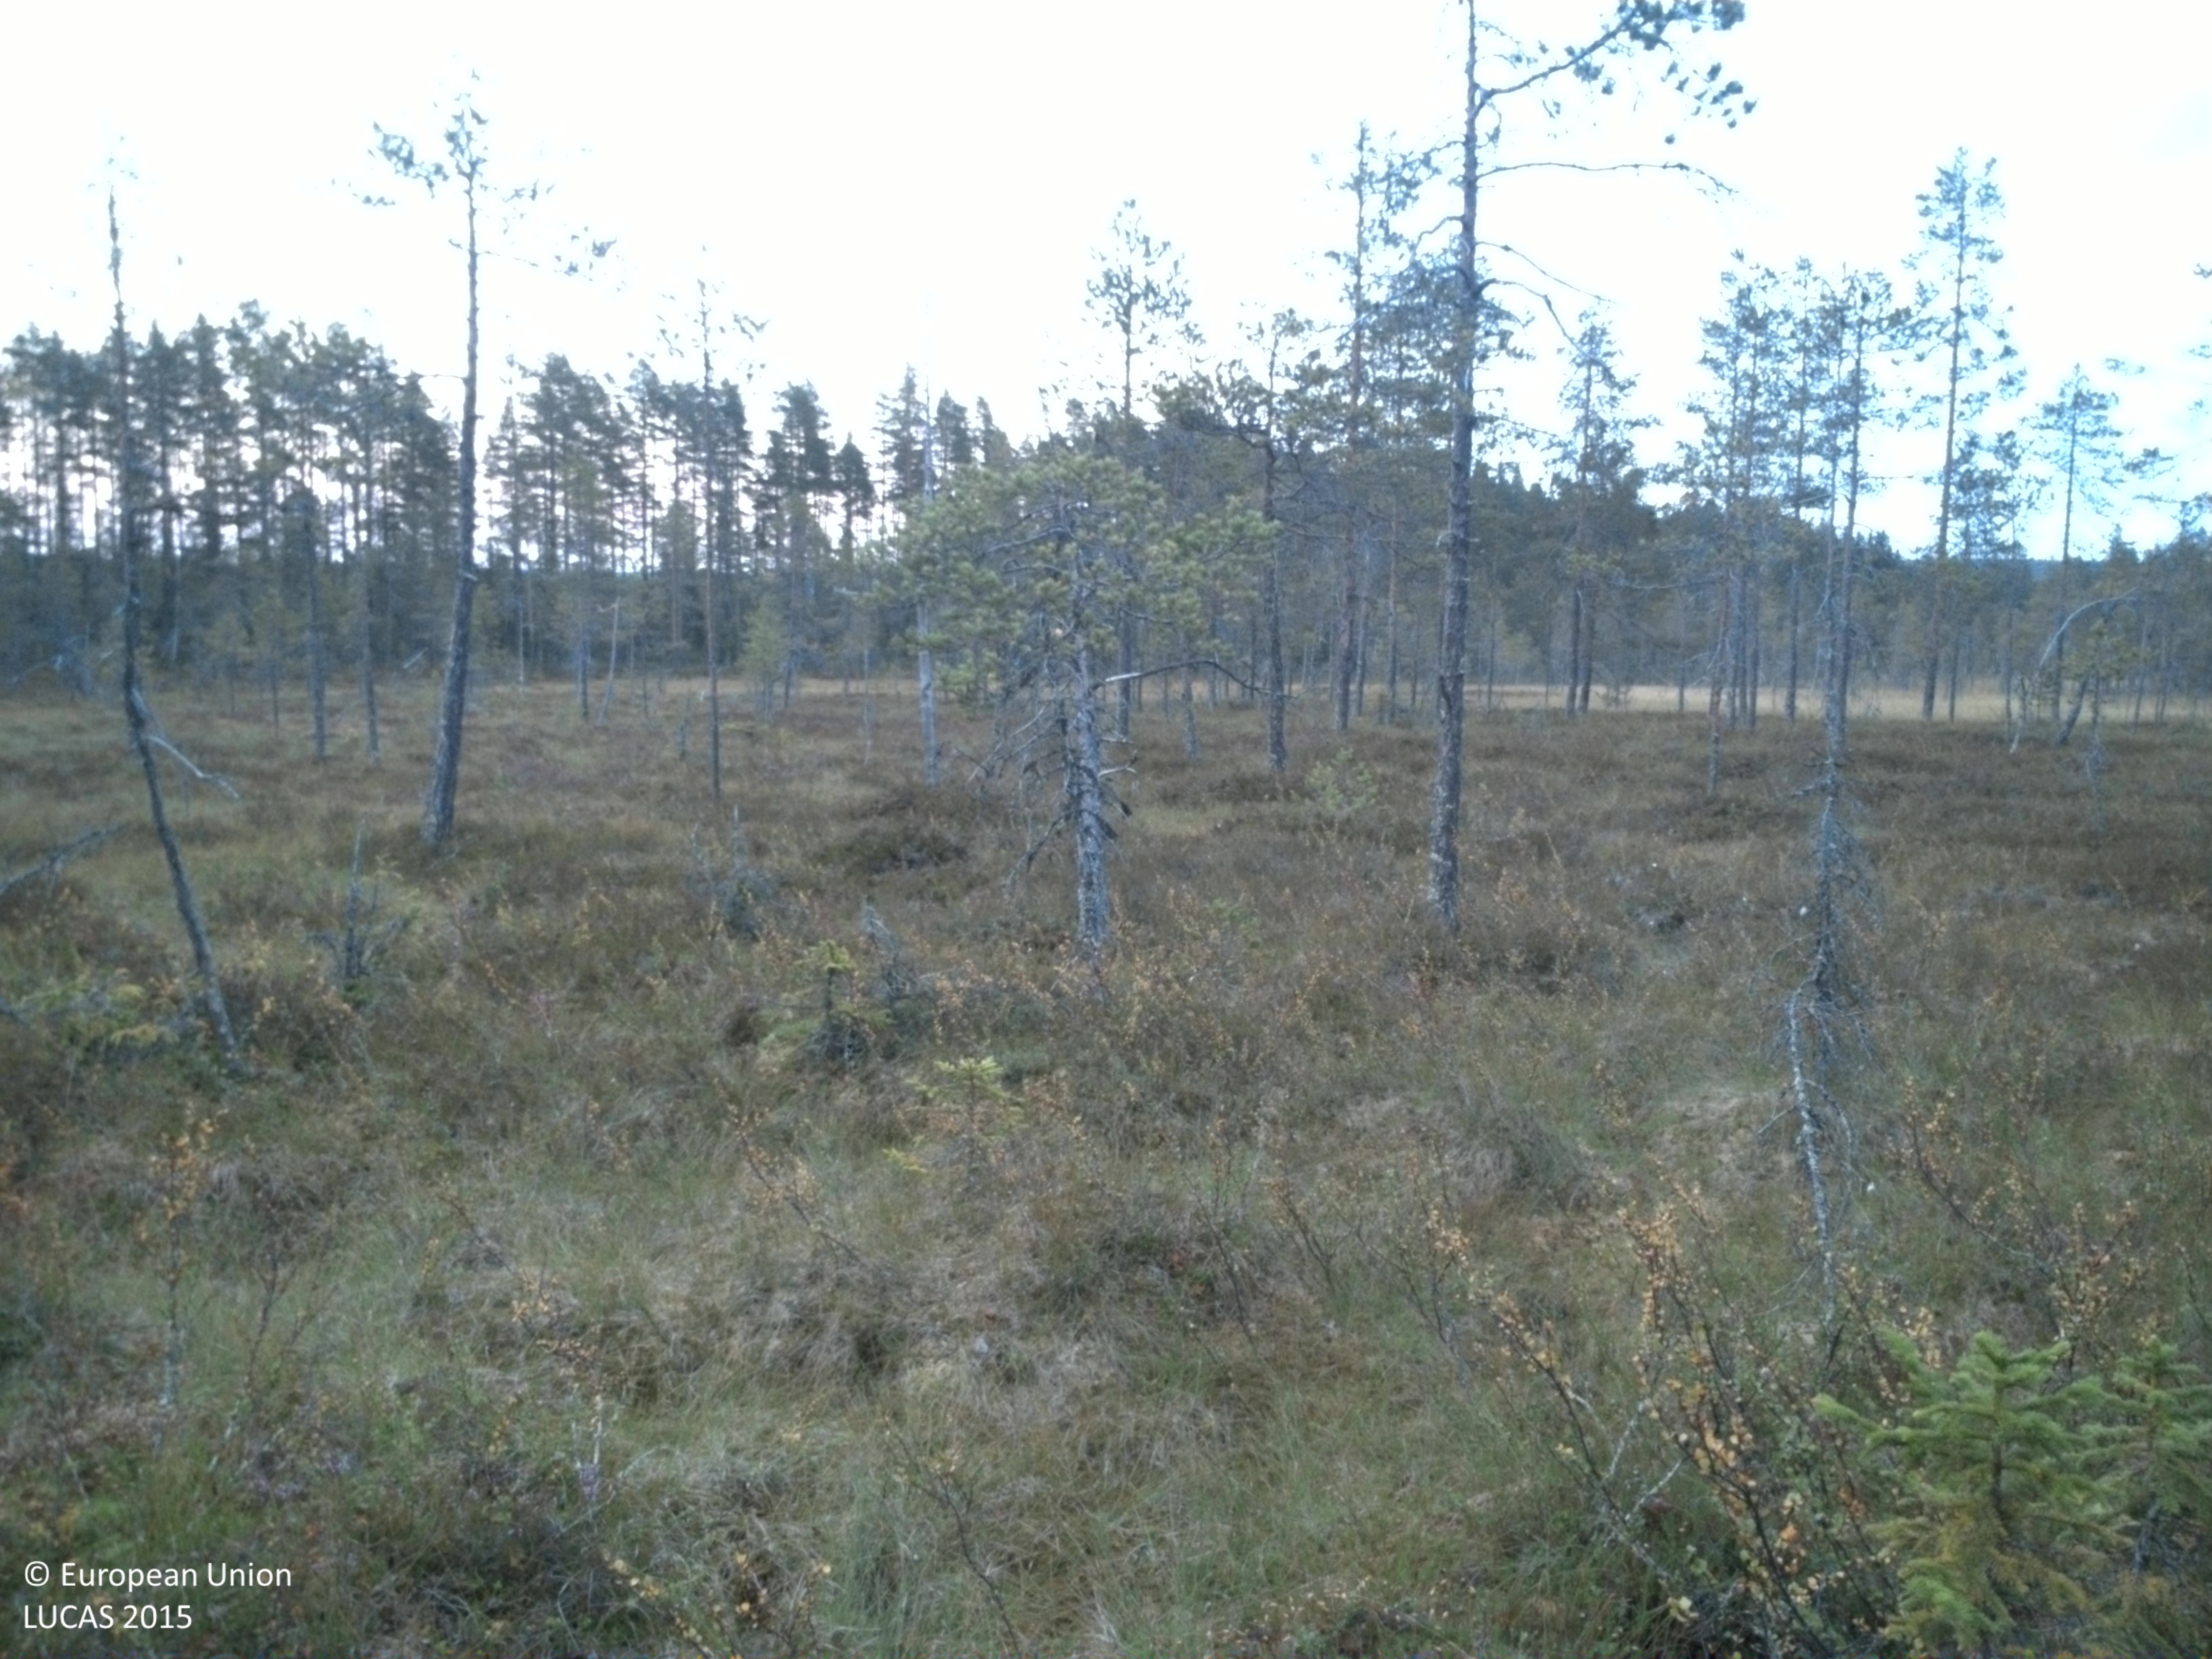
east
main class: Woodland
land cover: Other mixed woodland
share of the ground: 25 - 50 %
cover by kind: shrubs 25 %, lichens and mosses 25 %, coniferous forest trees 20 %, broadleaved forest trees 15 %, herbaceous plants 15 %
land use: Forestry
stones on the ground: < 10 %
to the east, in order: Other mixed woodland; Shrubland with sparse tree cover; Peatbogs; Pine dominated coniferous woodland; Pine dominated mixed woodland; Shrubland with sparse tree cover; Peatbogs; Pine dominated coniferous woodland
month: August
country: SE
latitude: 61.7793
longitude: 15.2720
